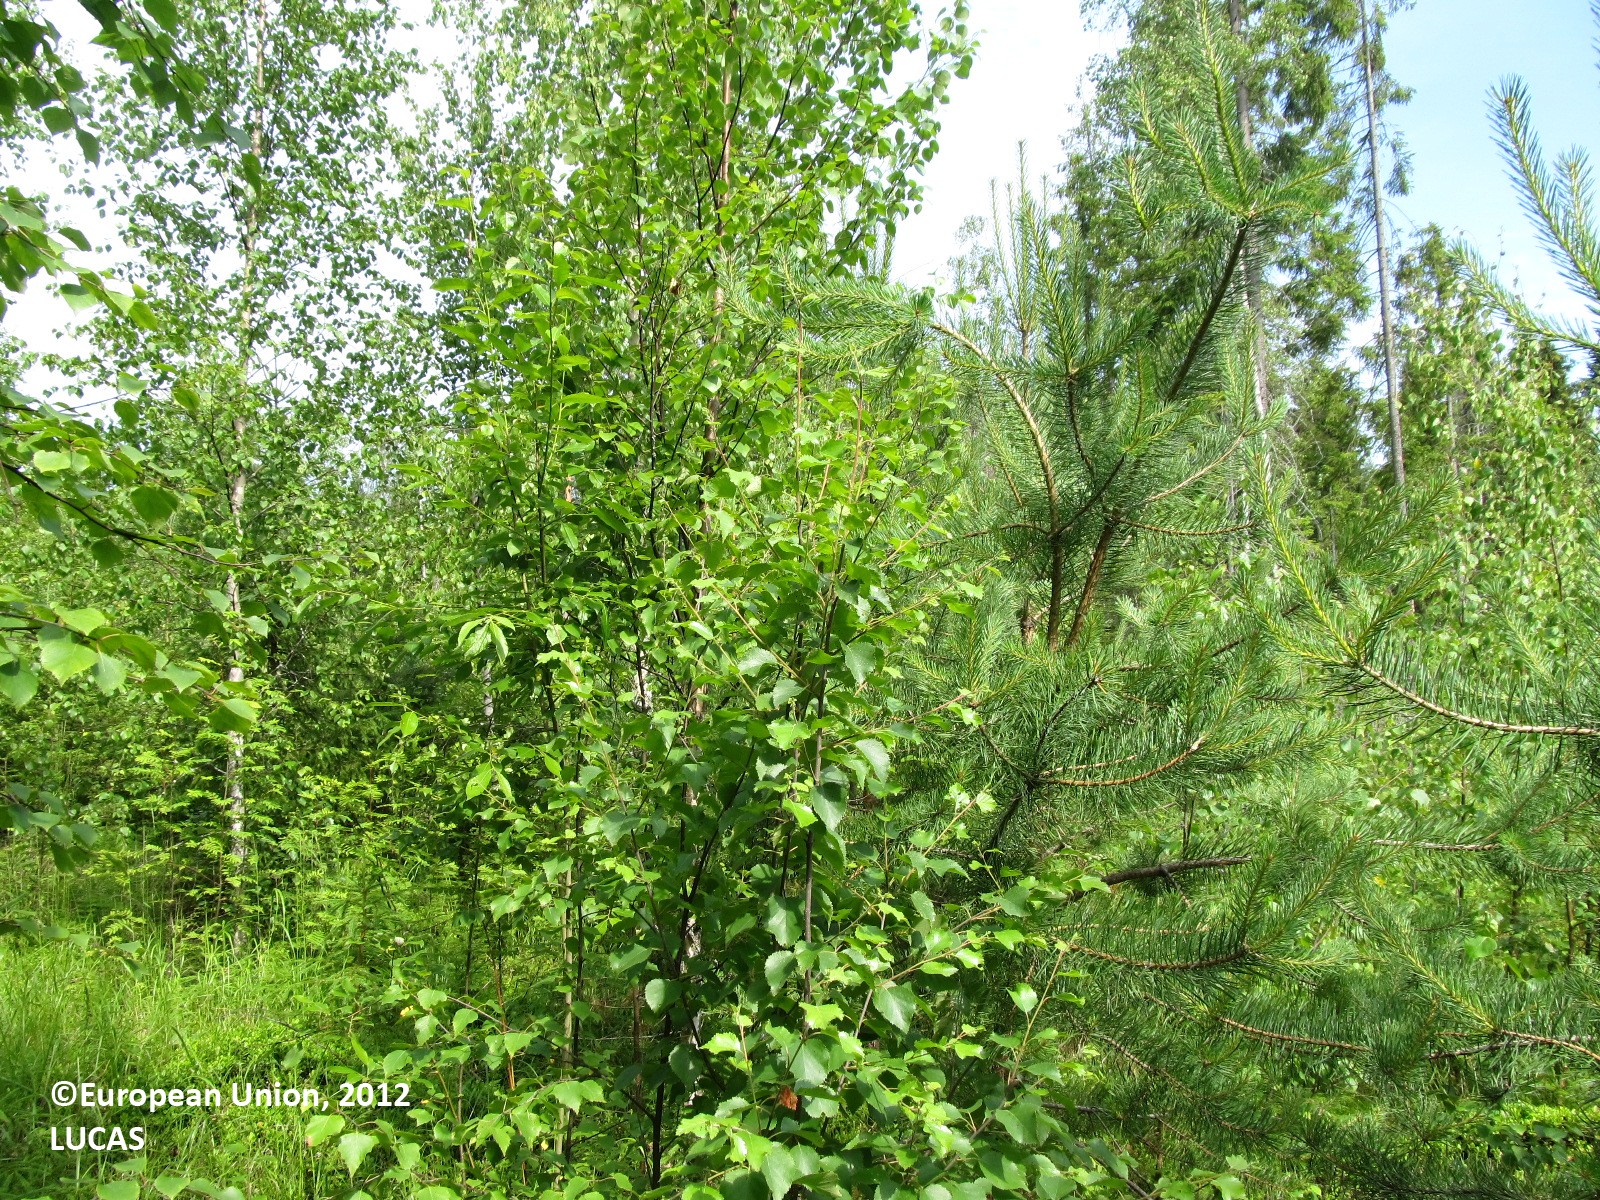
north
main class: Woodland
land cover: Pine dominated mixed woodland
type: boreal forest
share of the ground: 25 - 50 %
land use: Forestry
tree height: < 5 m
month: July
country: FI
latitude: 61.9286
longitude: 29.1081
